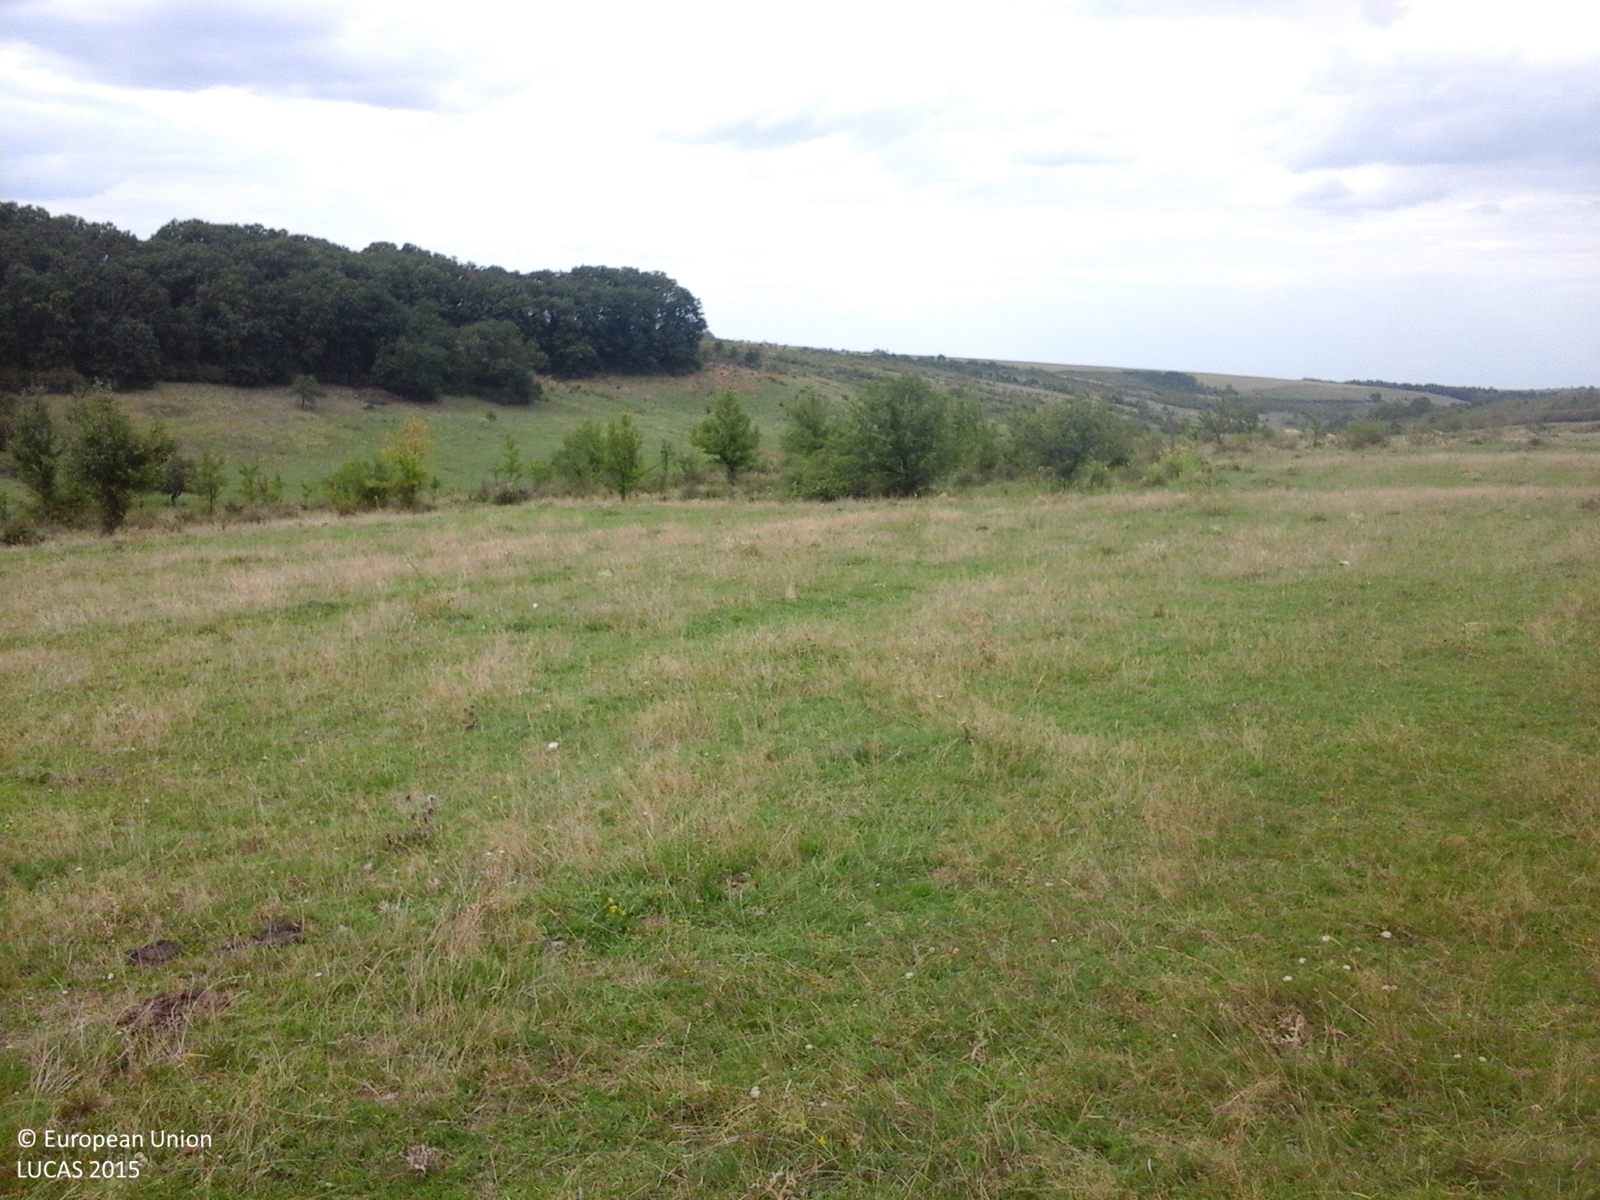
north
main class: Grassland
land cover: Grassland without tree/shrub cover
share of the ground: > 75 %
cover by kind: herbaceous plants 100 %
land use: Agriculture (excluding fallow land and kitchen gardens)
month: September
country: RO
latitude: 47.4345
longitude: 22.6684
